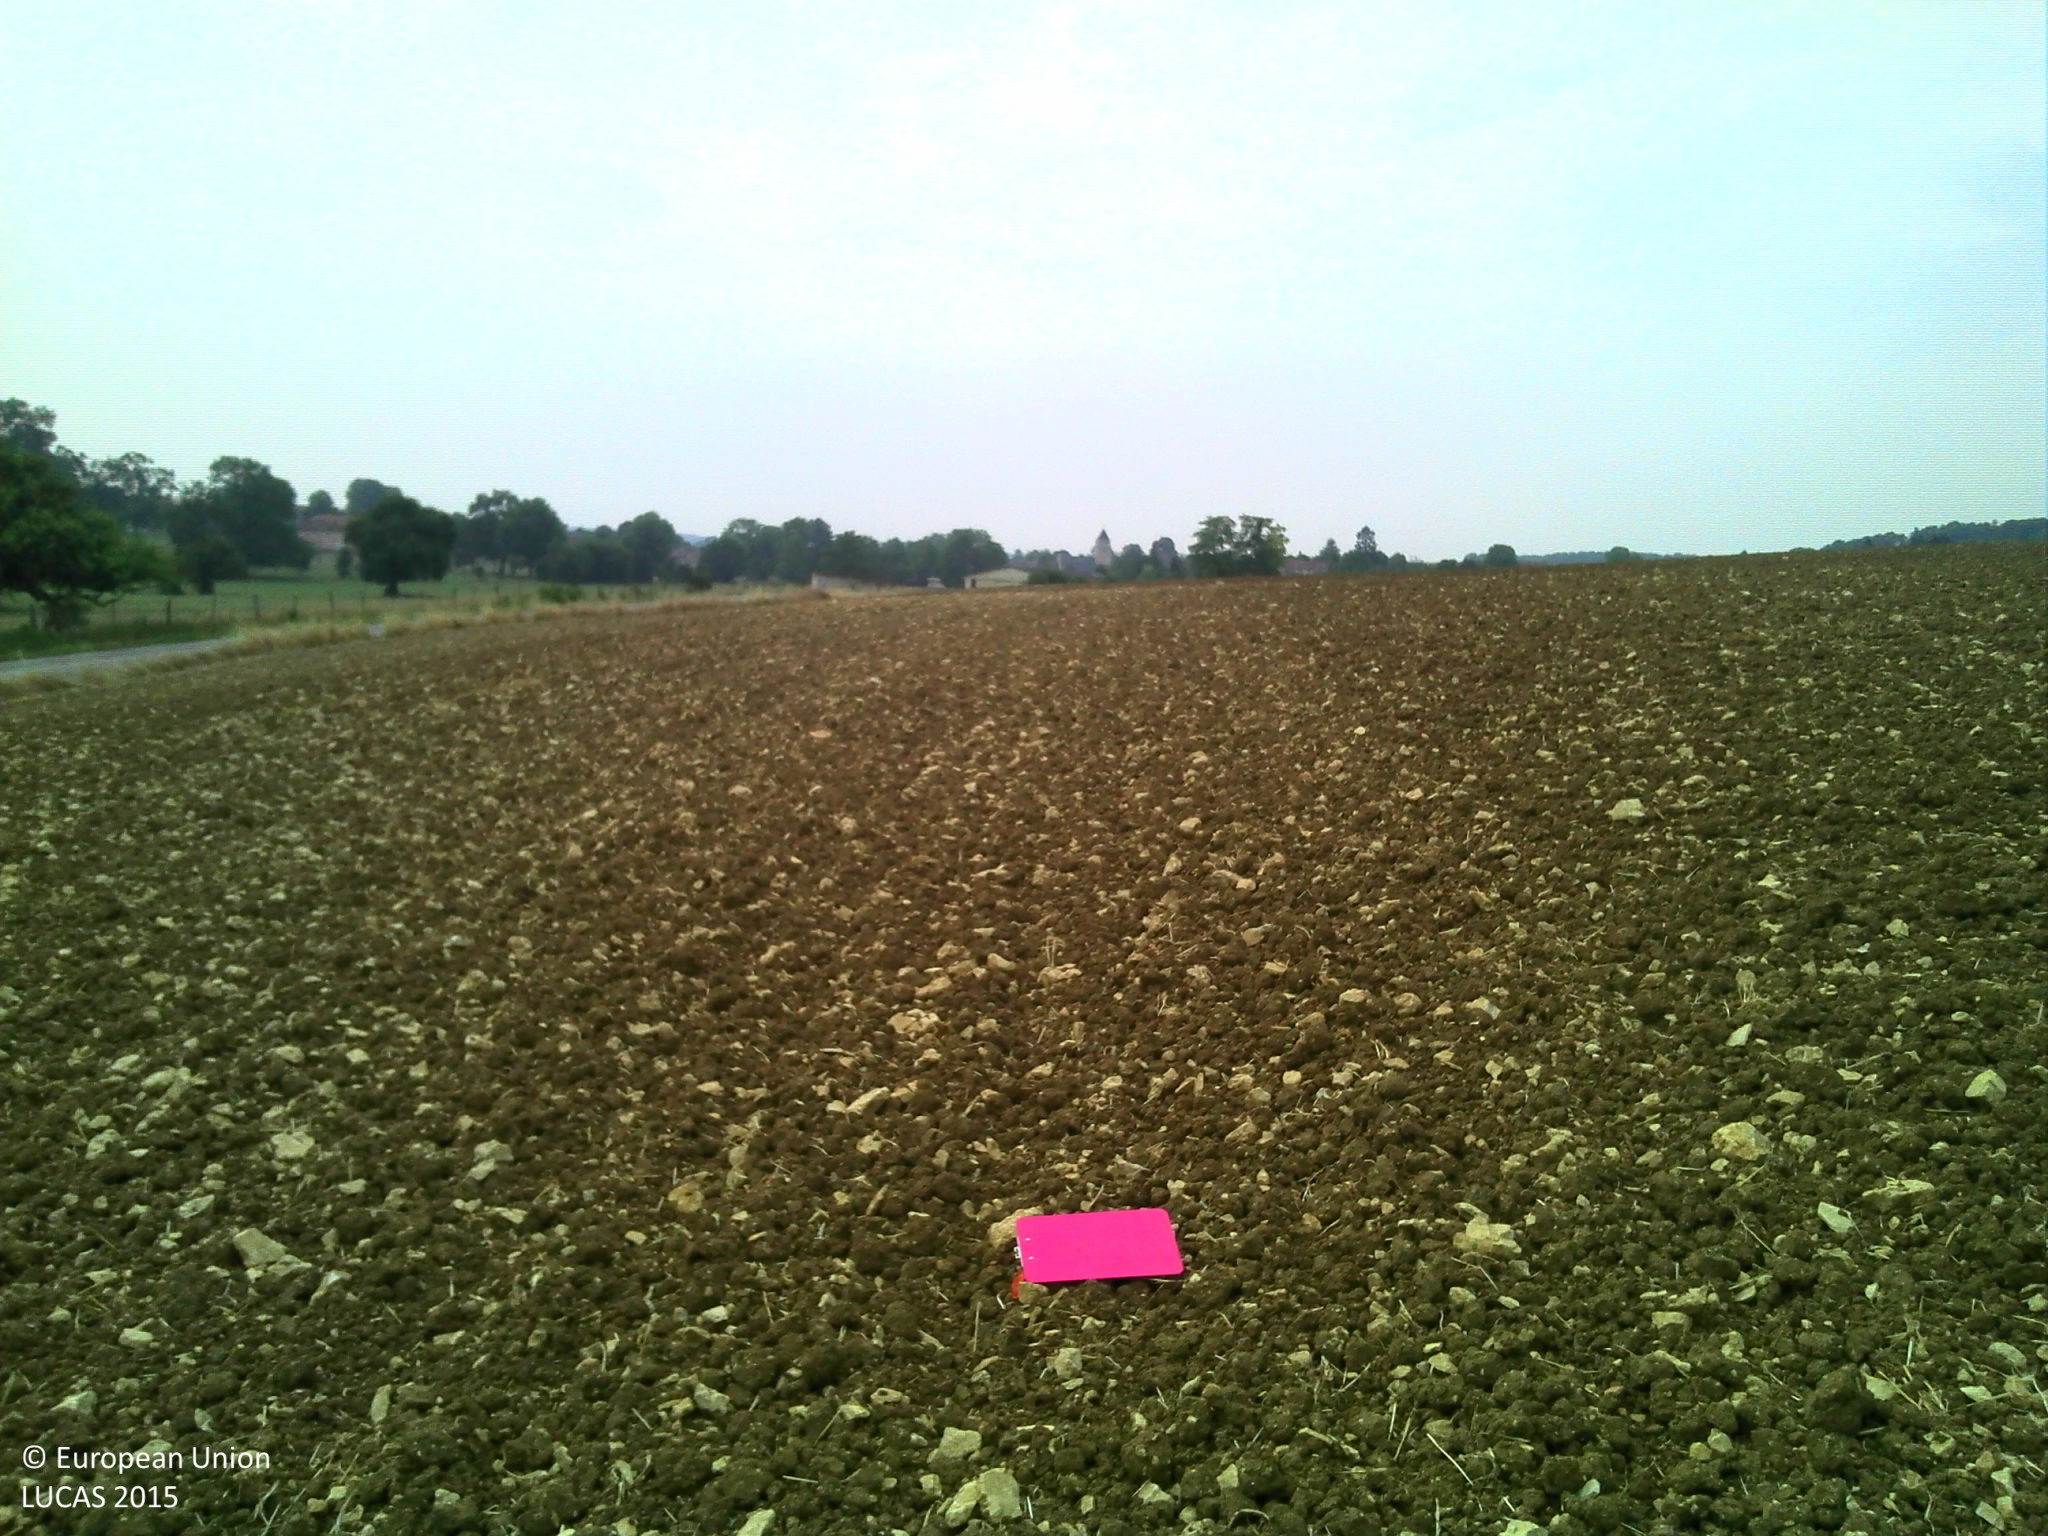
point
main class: Cropland
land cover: Barley
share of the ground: < 10 %
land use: Agriculture (excluding fallow land and kitchen gardens)
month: August
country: FR
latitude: 49.3396
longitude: 5.0845
